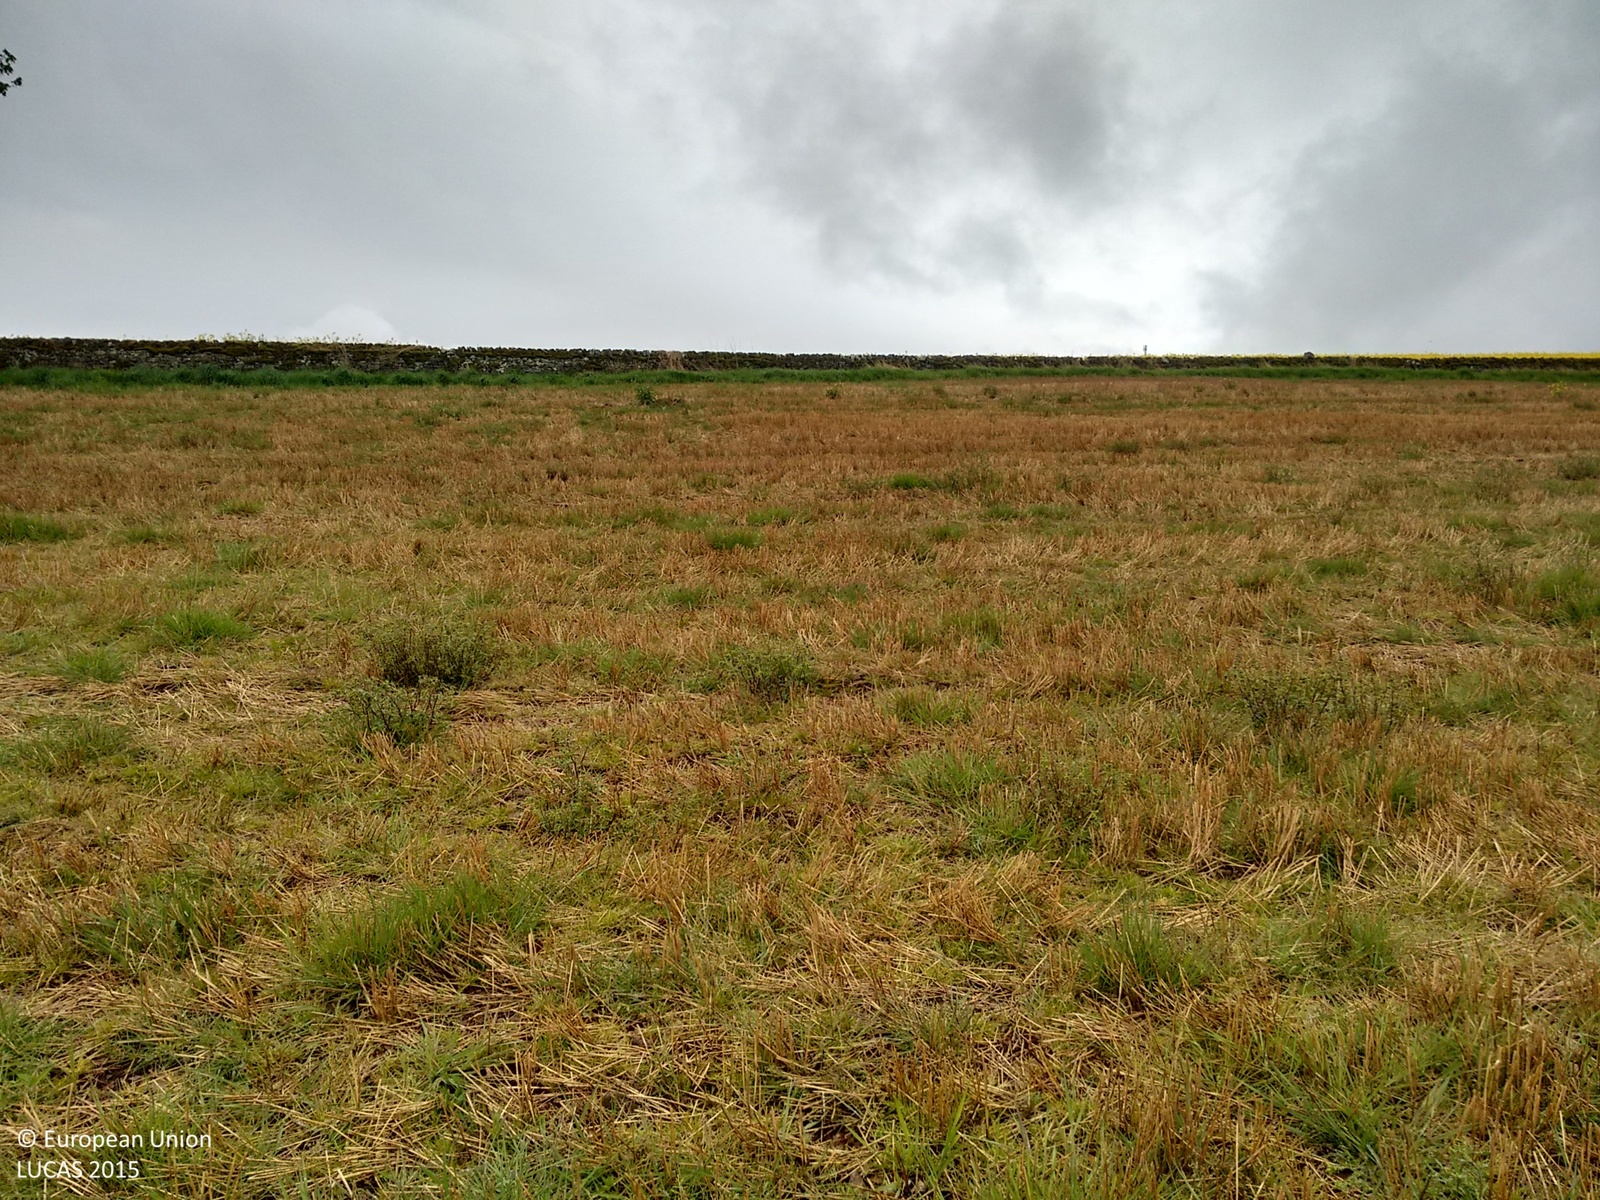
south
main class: Grassland
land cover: Grassland without tree/shrub cover
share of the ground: > 75 %
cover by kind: herbaceous plants 100 %
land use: Agriculture (excluding fallow land and kitchen gardens)
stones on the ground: 10 - 25 %
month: May
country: GB
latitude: 56.6215
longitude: -2.5910
